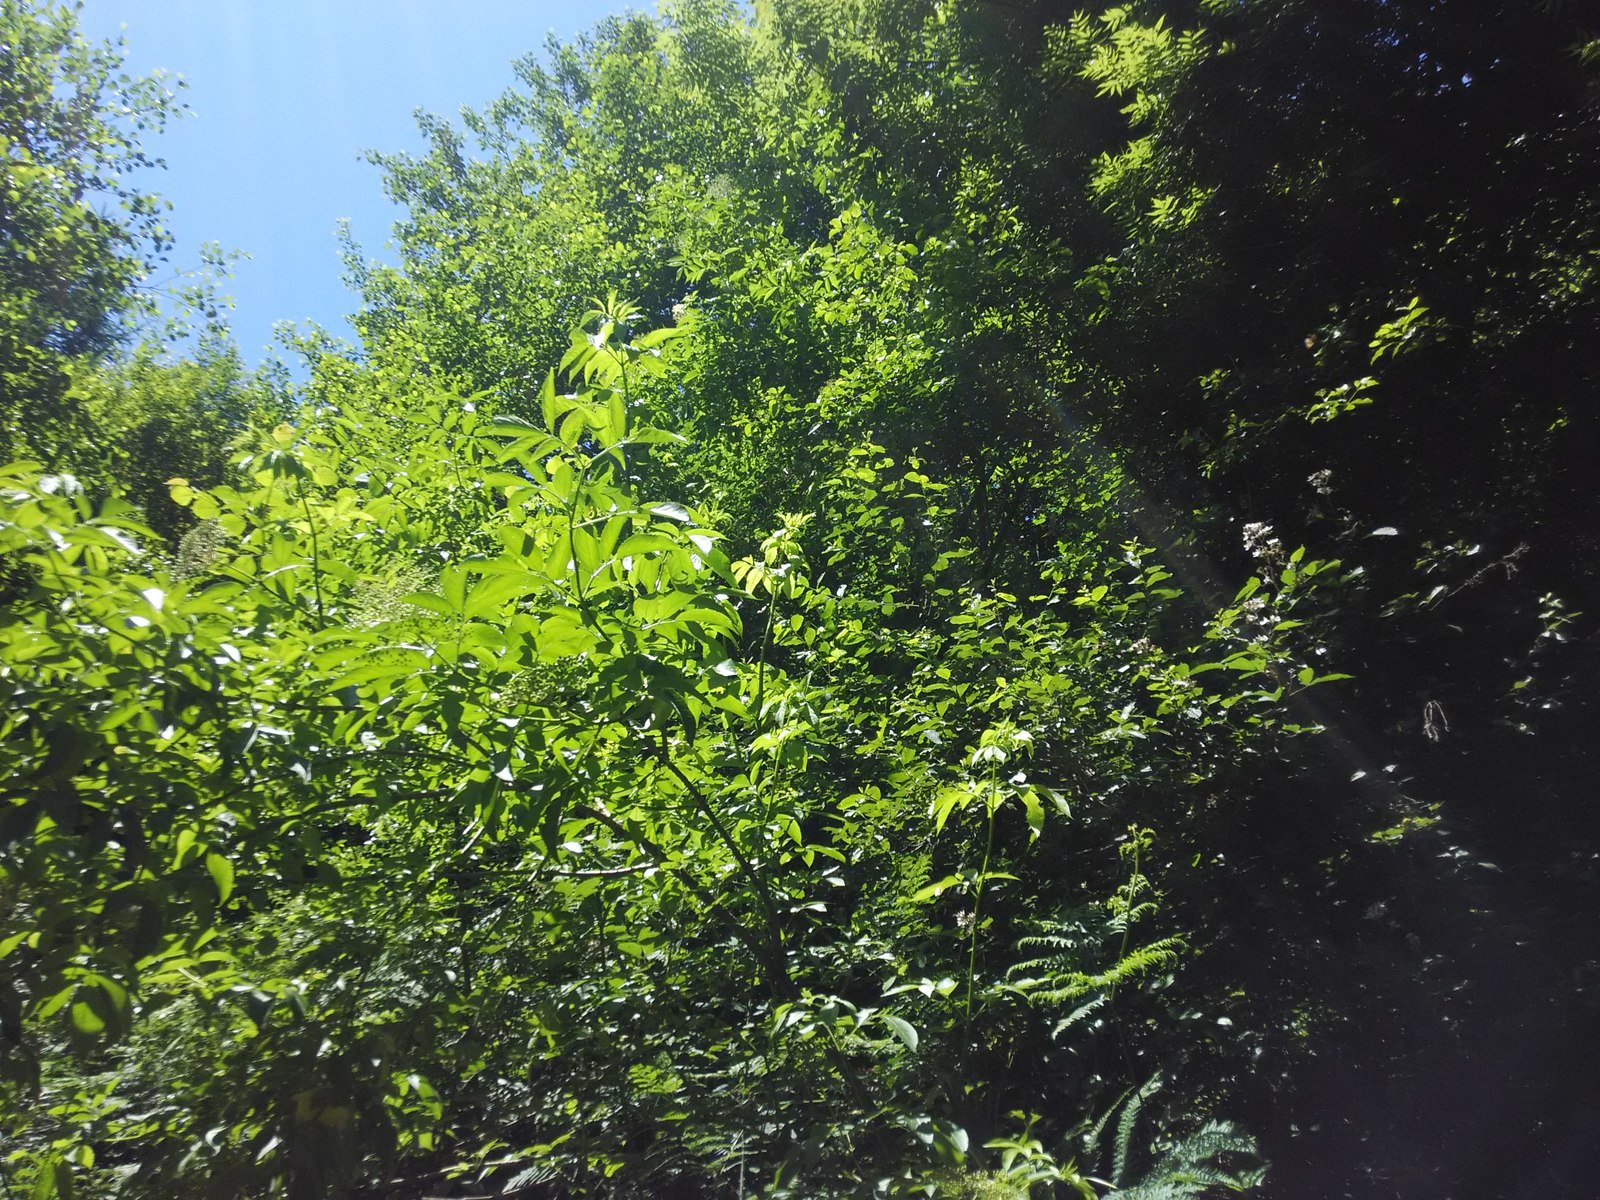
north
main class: Woodland
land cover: Other mixed woodland
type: thermophilous deciduous forest
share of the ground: > 75 %
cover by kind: broadleaved forest trees 60 %, coniferous forest trees 40 %
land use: Forestry
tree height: > 5 m
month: June
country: ES
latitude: 43.2149
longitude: -2.4478
